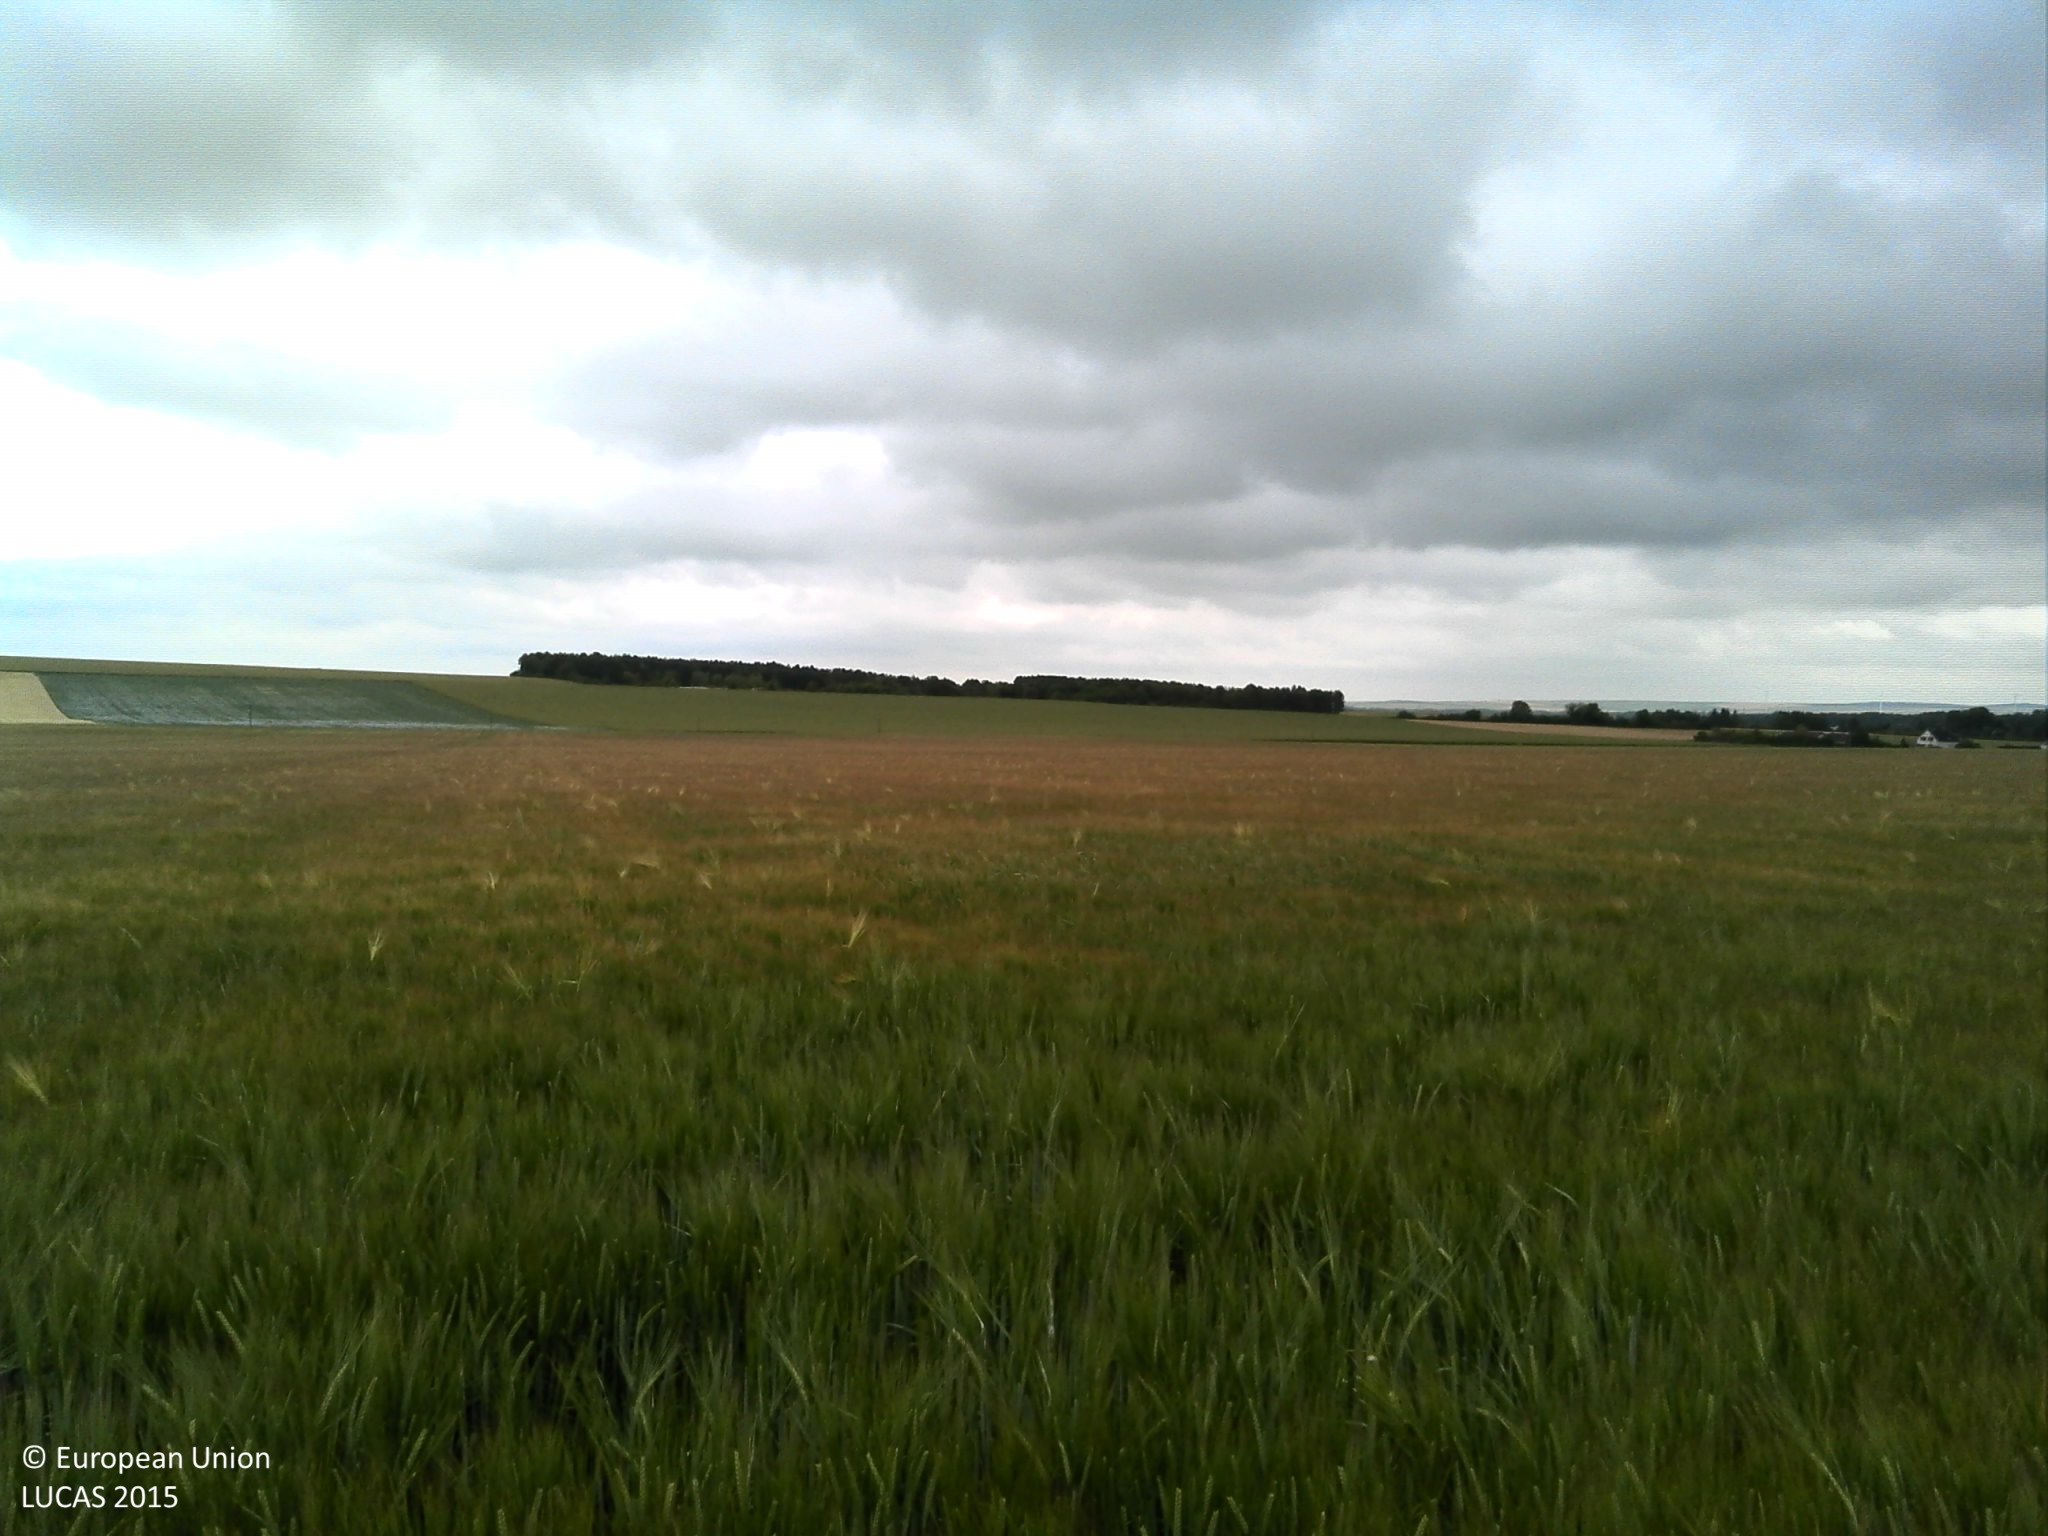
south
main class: Cropland
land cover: Barley
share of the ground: > 75 %
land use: Agriculture (excluding fallow land and kitchen gardens)
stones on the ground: < 10 %
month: June
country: FR
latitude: 48.5792
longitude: 4.2628
